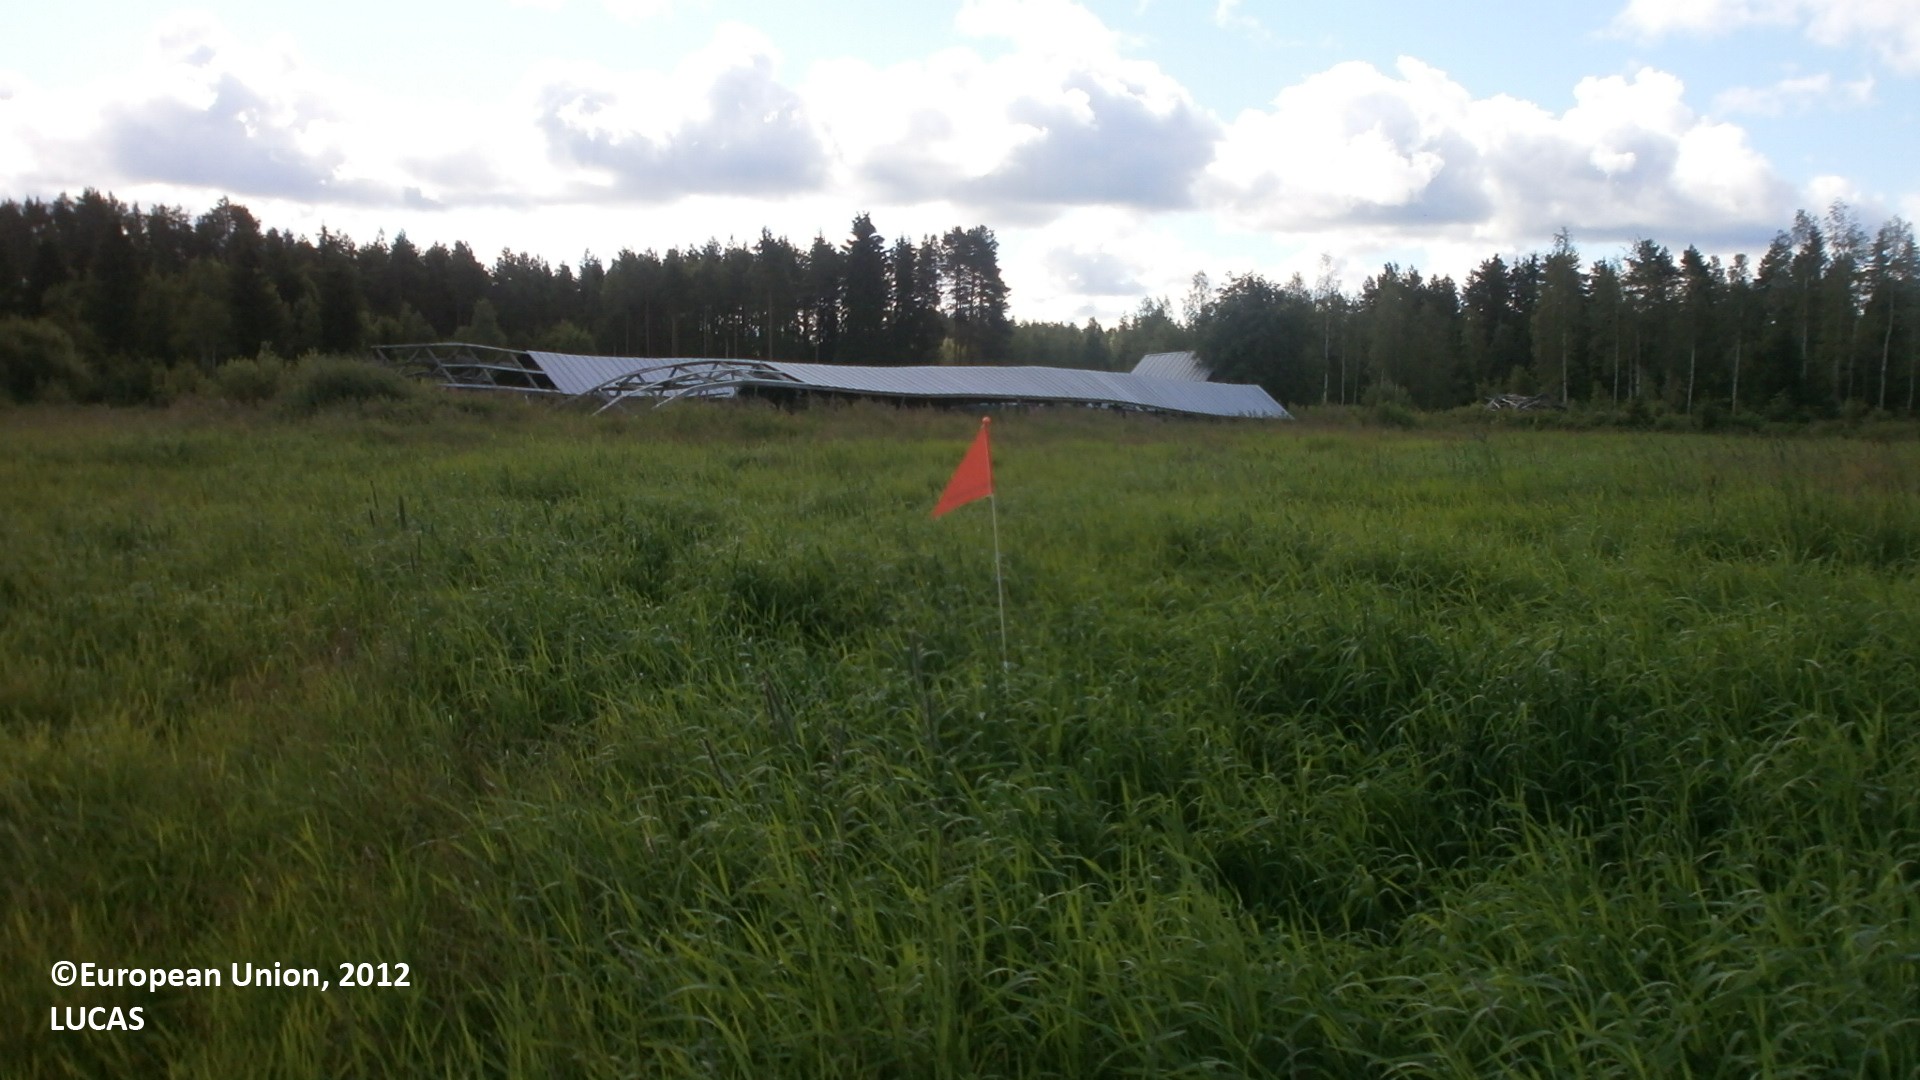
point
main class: Cropland
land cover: Temporary grasslands
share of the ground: > 75 %
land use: Agriculture (excluding fallow land and kitchen gardens)
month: July
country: FI
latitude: 64.0904
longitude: 24.1591
